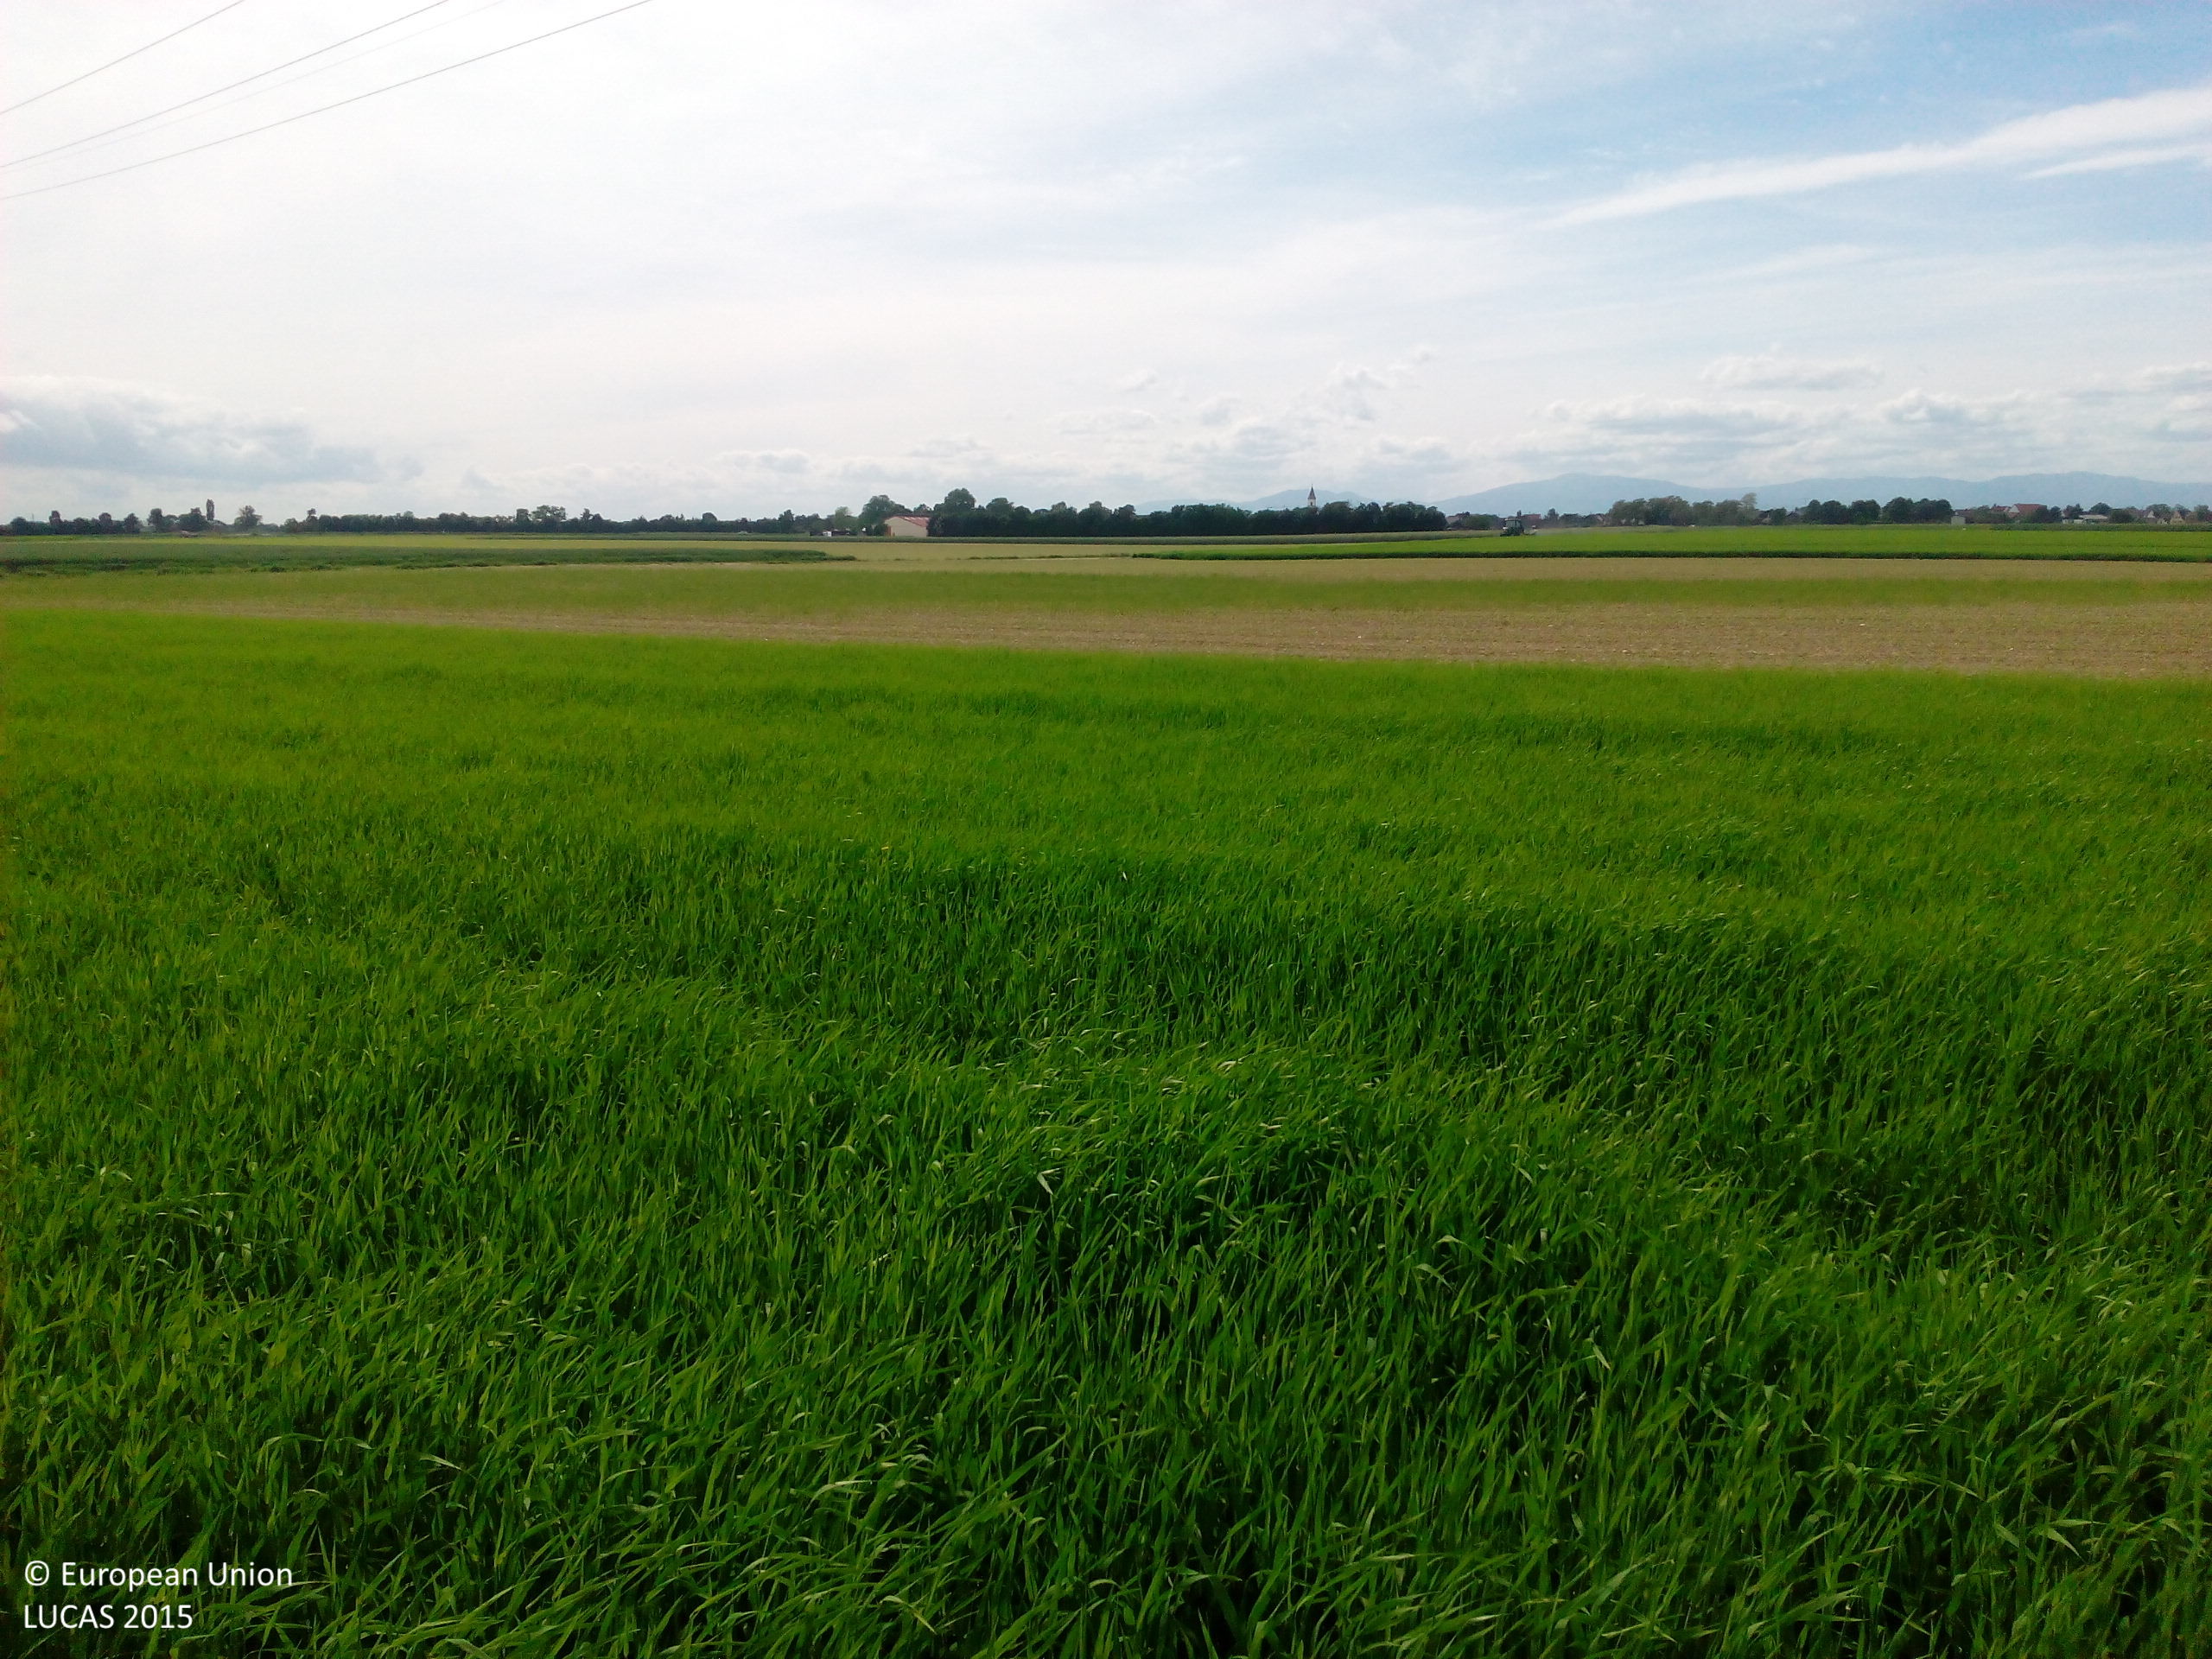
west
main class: Cropland
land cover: Barley
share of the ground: > 75 %
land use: Agriculture (excluding fallow land and kitchen gardens)
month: May
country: DE
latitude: 47.8735
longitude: 7.6081
